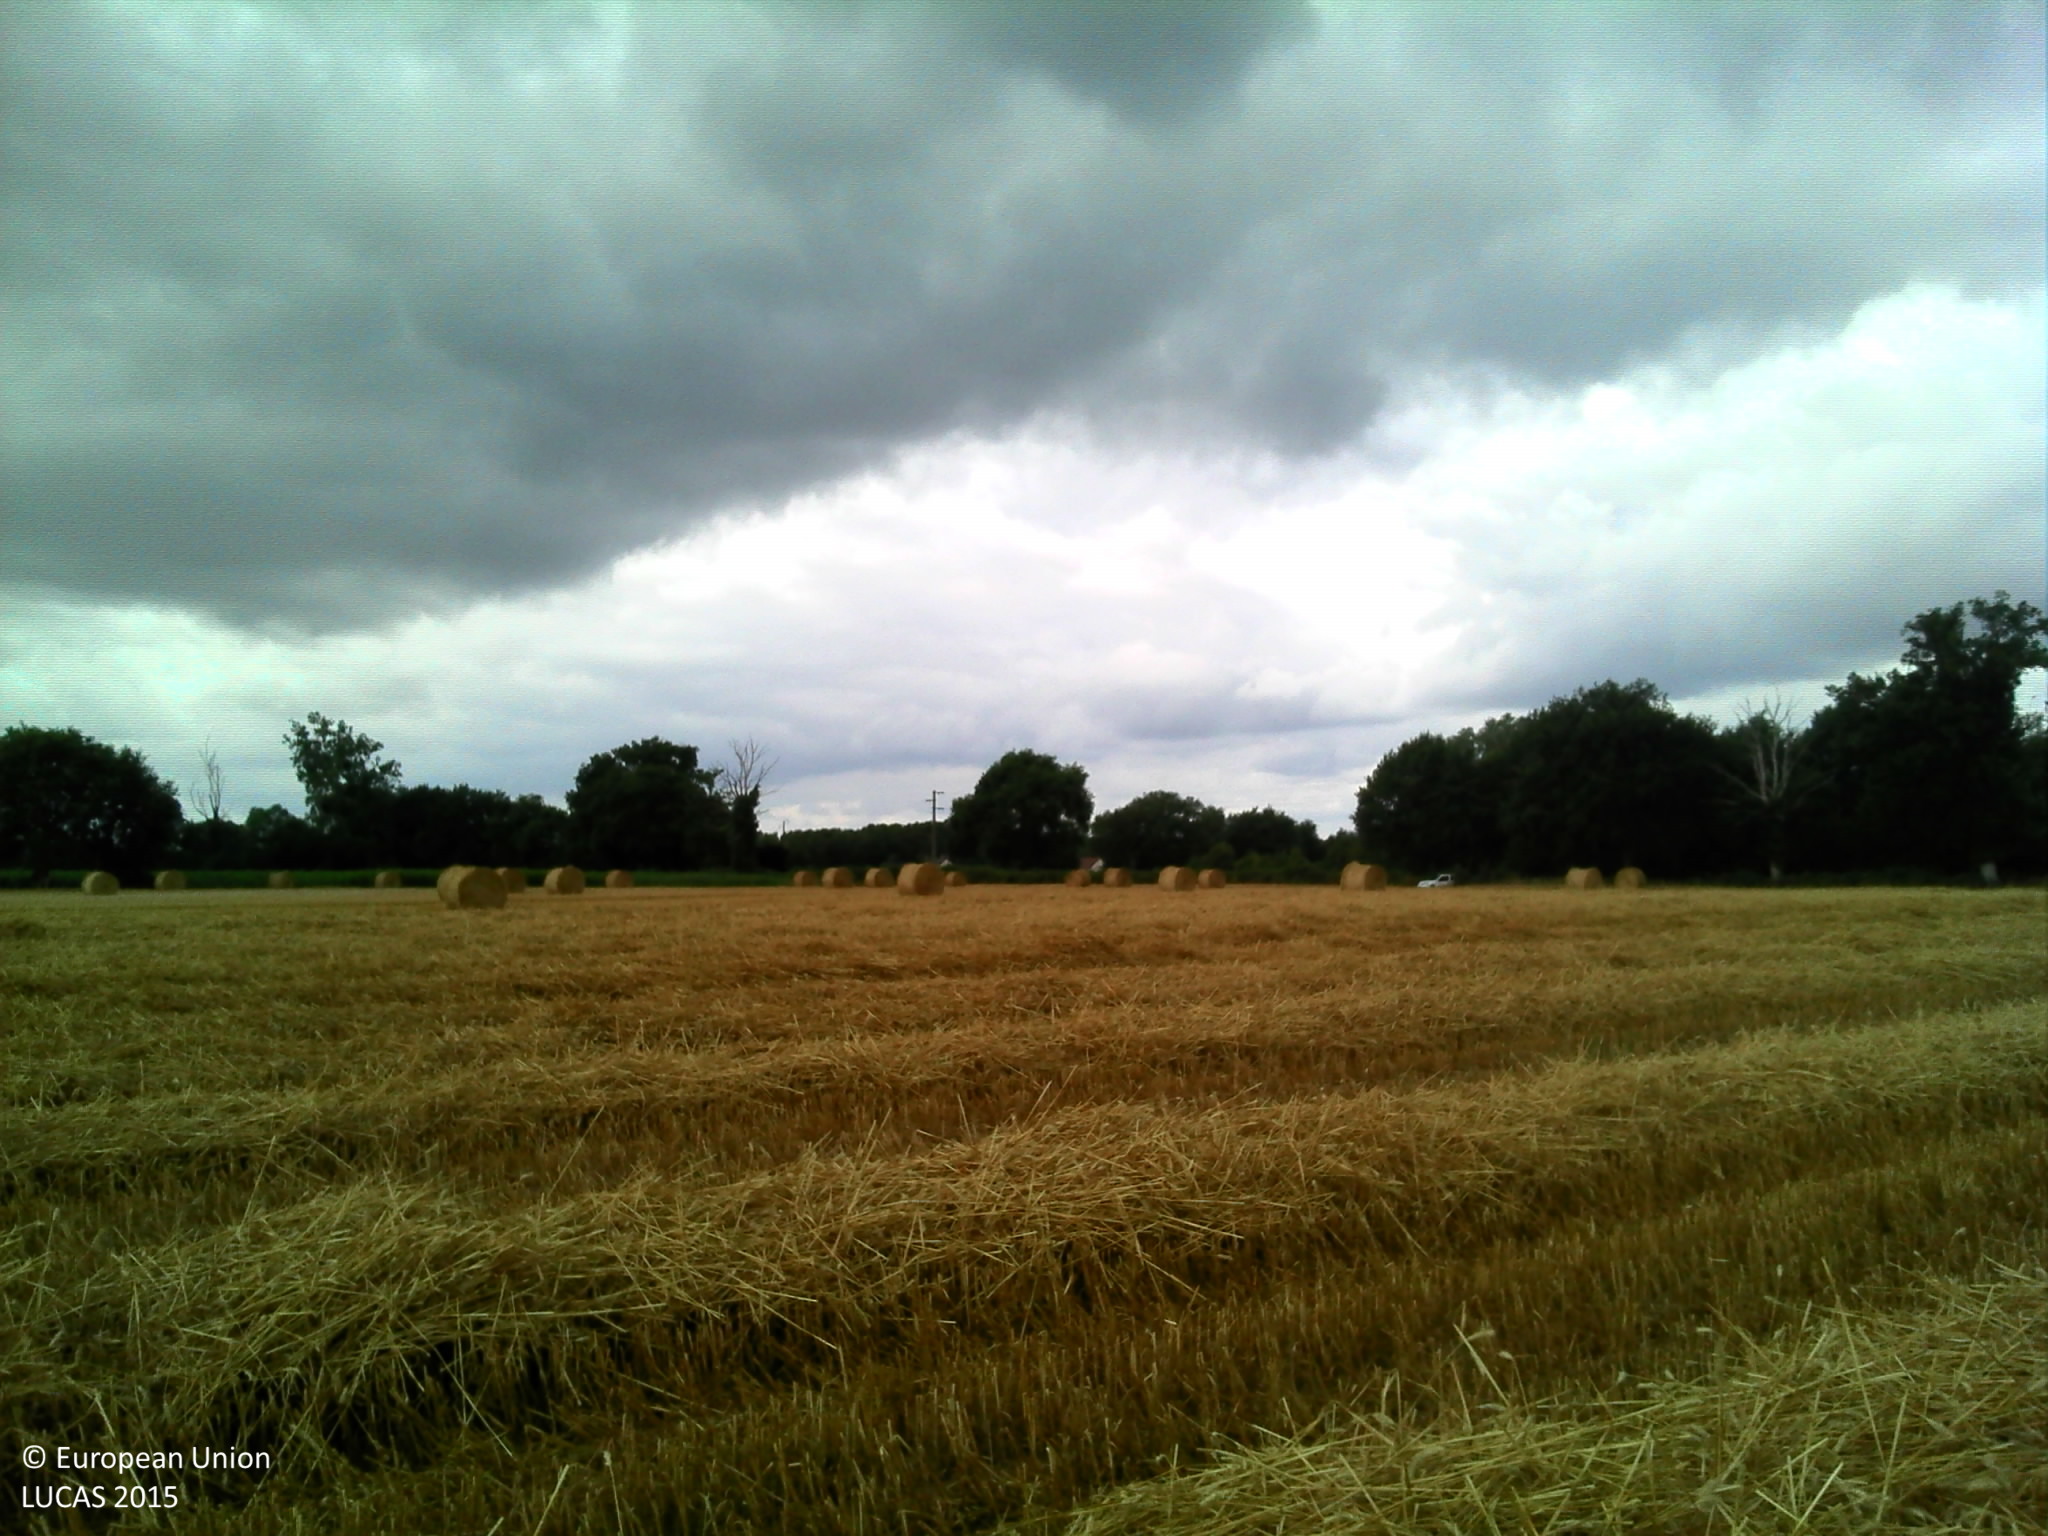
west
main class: Cropland
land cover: Triticale
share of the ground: > 75 %
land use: Agriculture (excluding fallow land and kitchen gardens)
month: July
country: FR
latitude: 47.7542
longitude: 0.2508
